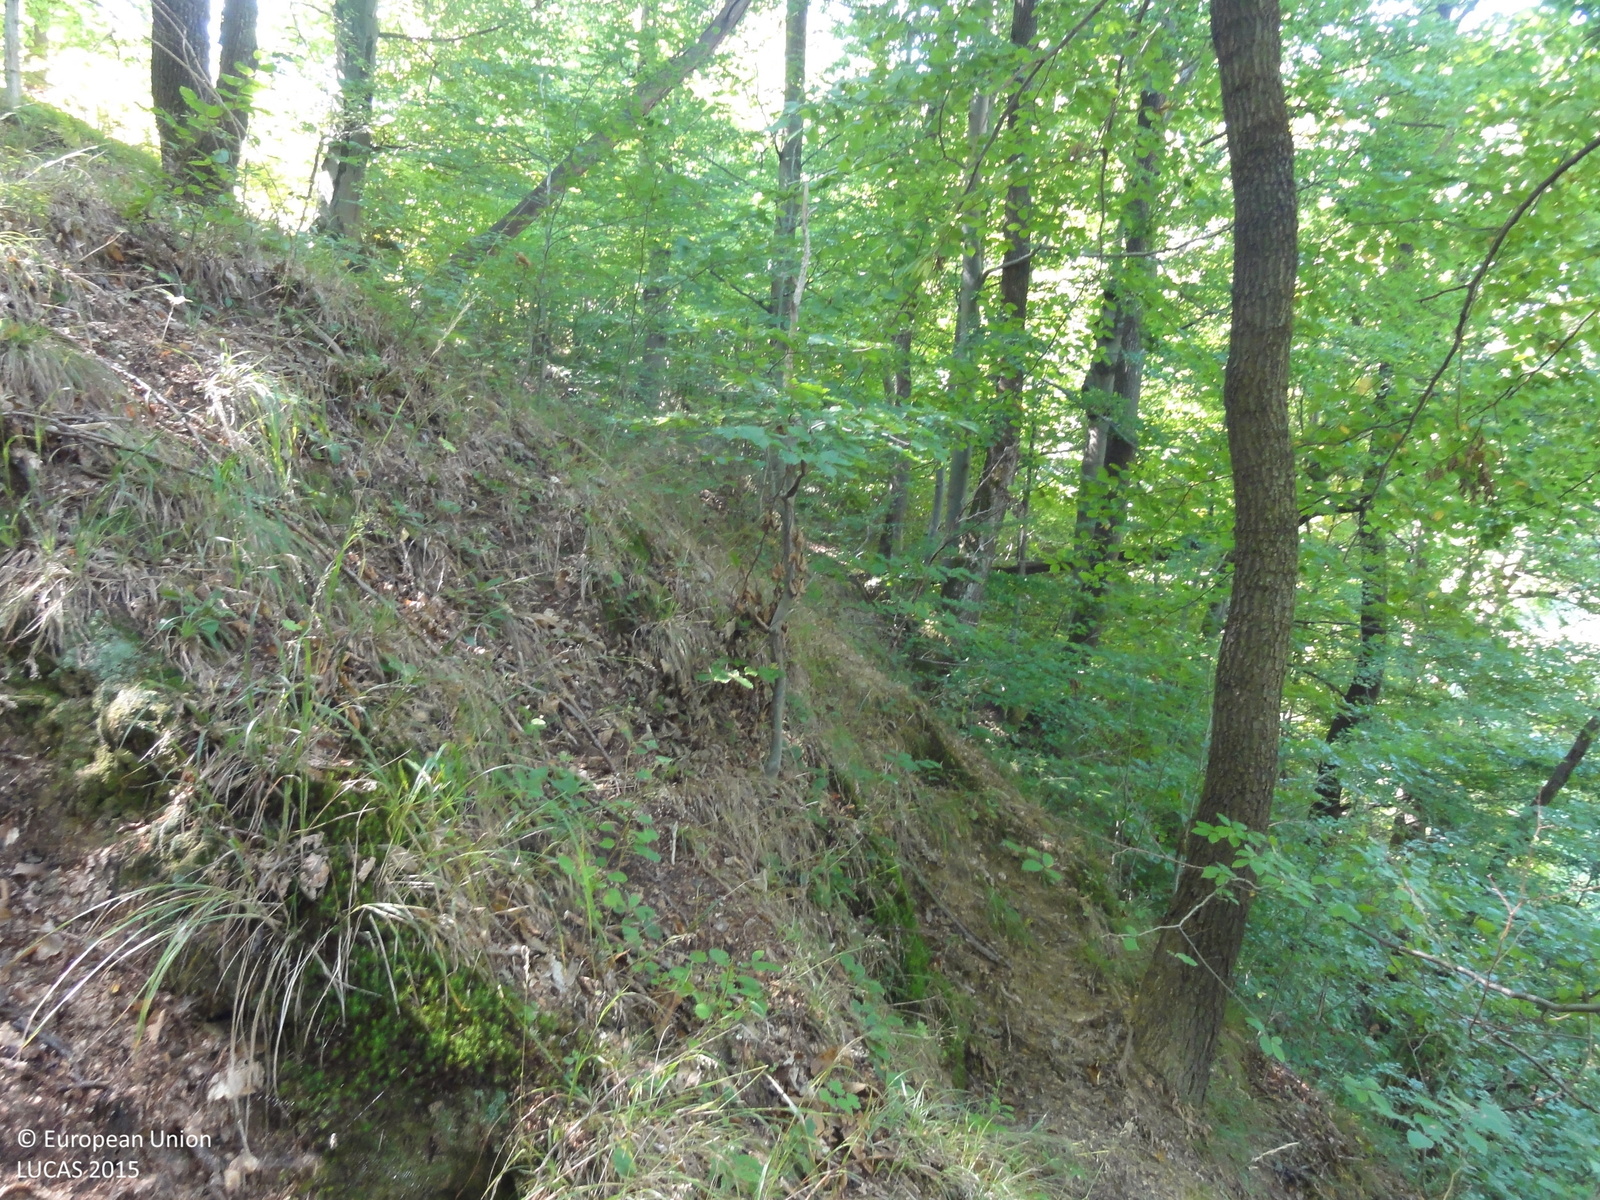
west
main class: Woodland
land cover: Broadleaved woodland
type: beech forest
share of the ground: > 75 %
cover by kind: broadleaved forest trees 95 %, coniferous forest trees 5 %
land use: Forestry
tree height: > 5 m
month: August
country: SI
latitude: 46.0118
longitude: 15.4864
